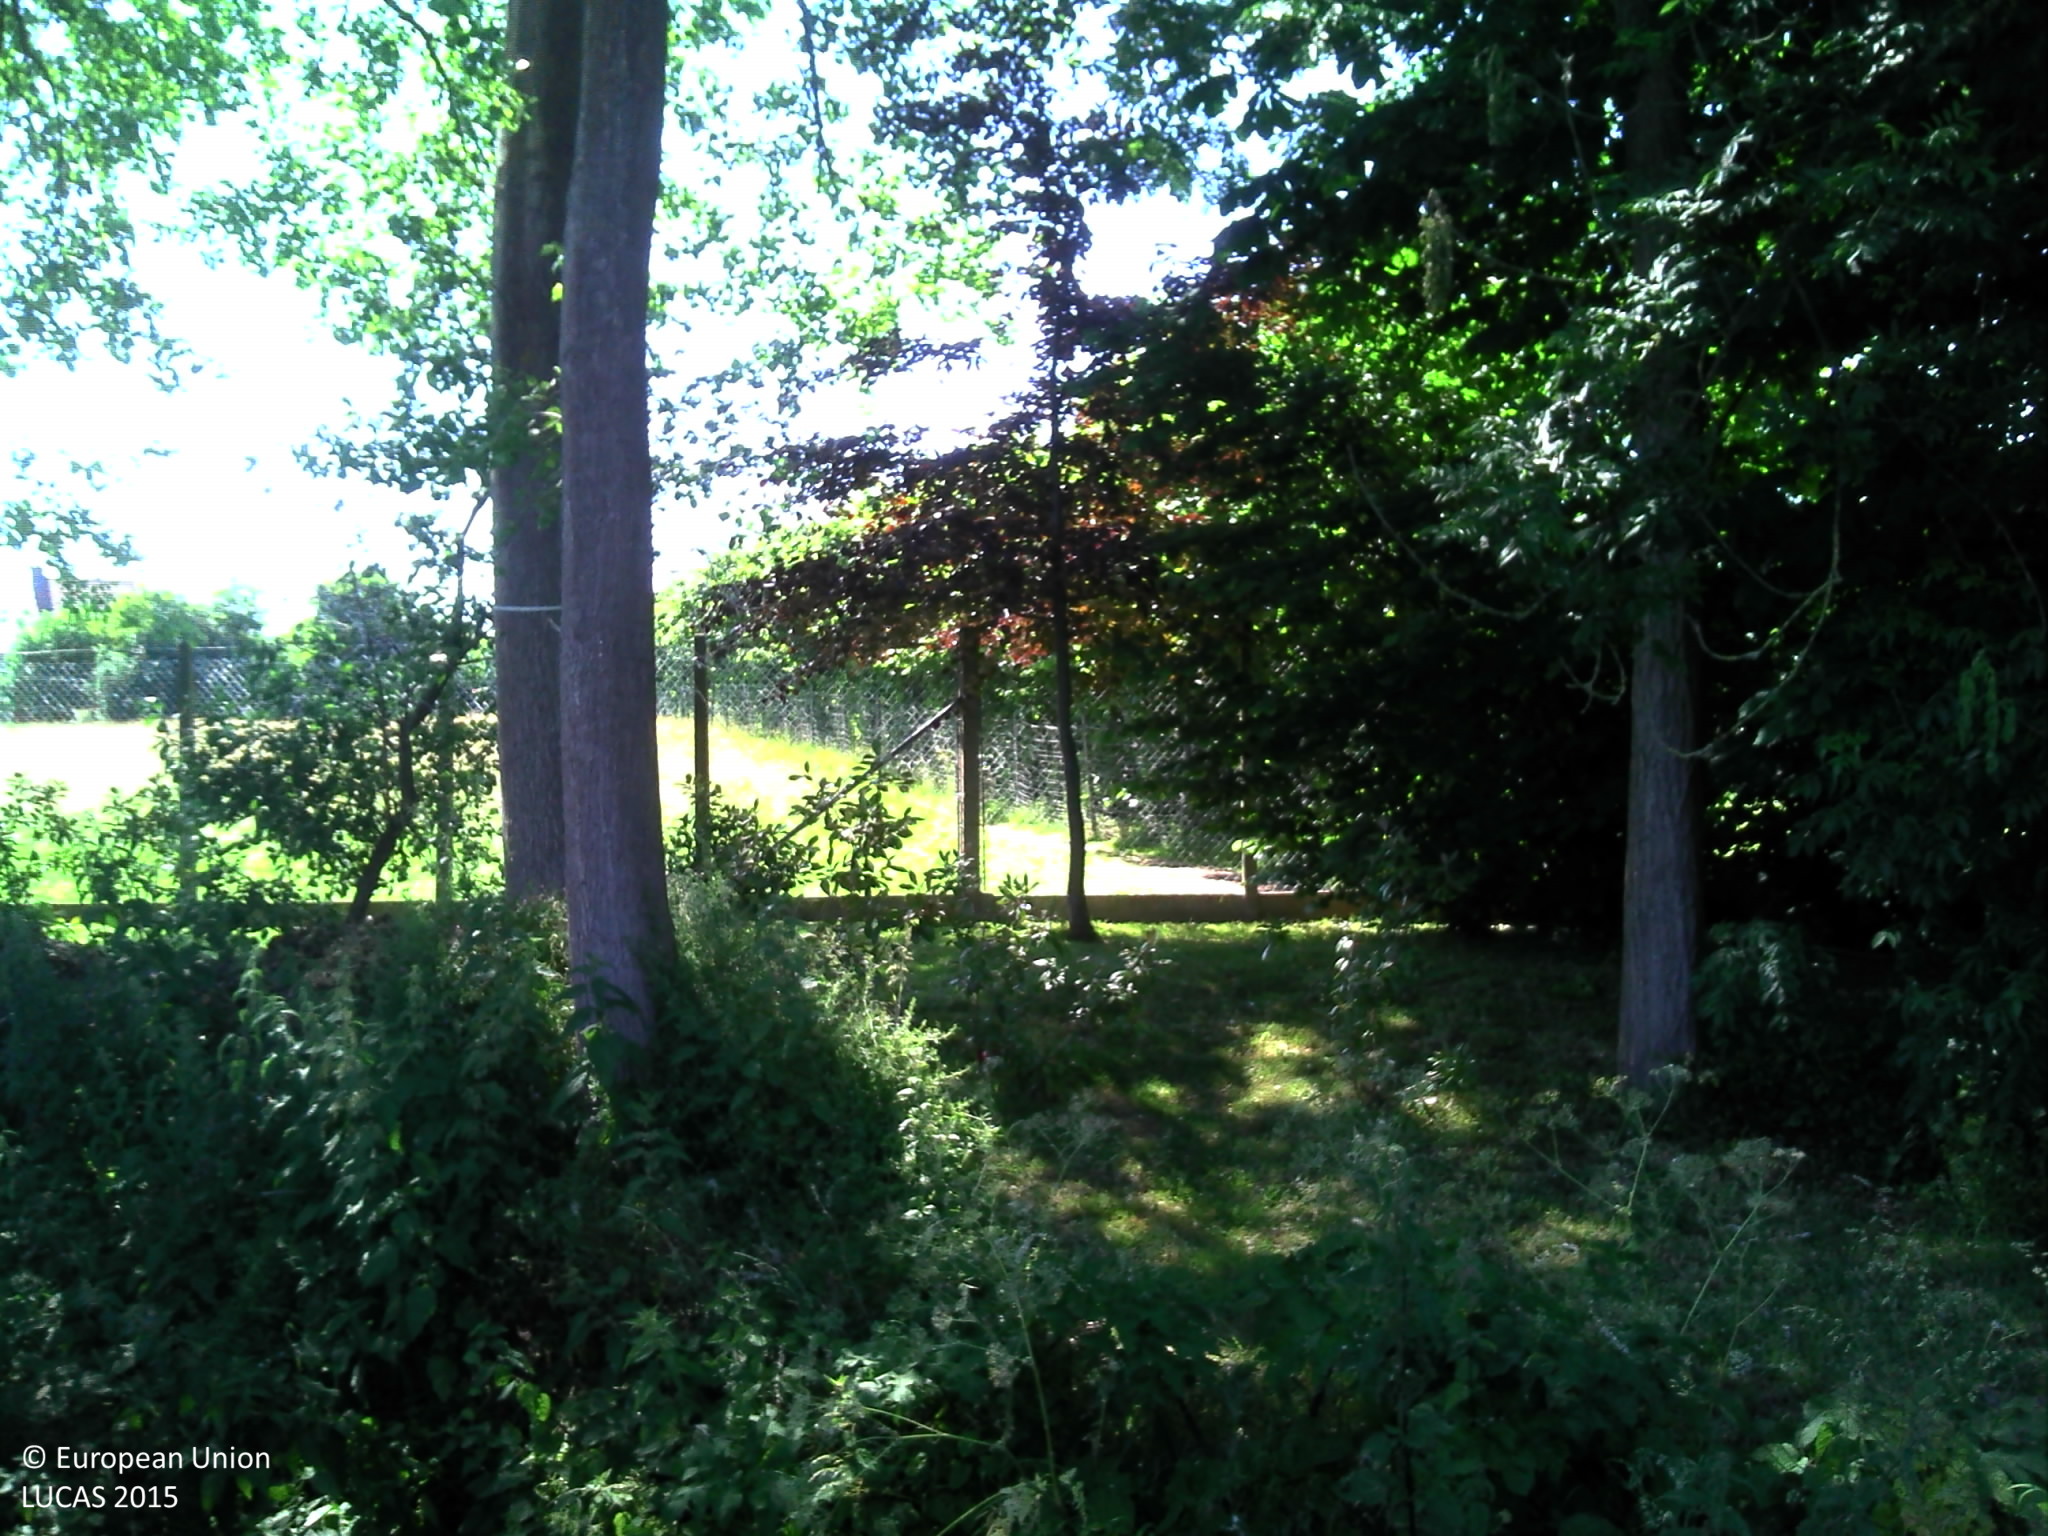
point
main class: Grassland
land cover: Grassland without tree/shrub cover
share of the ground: > 75 %
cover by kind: herbaceous plants 100 %
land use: Residential
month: June
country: BE
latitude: 50.7993
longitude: 3.6221
